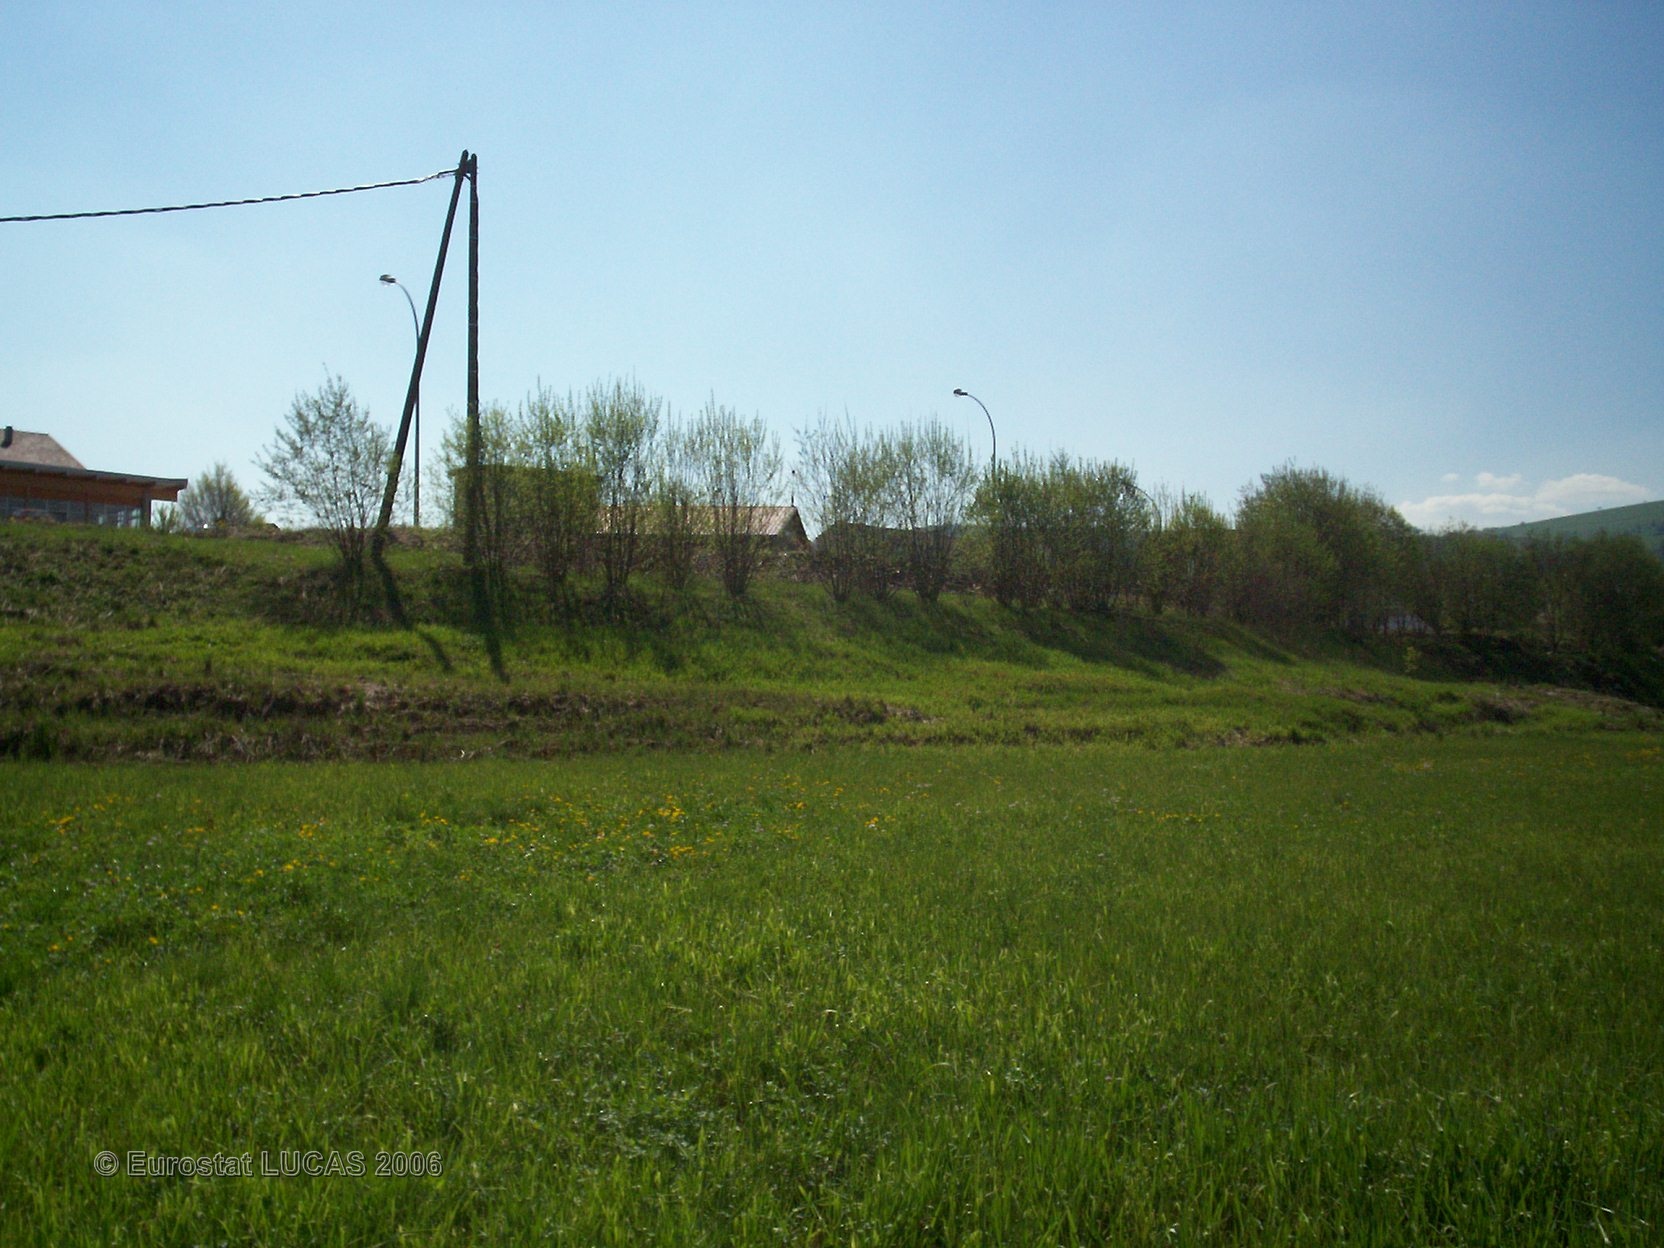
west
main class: Grassland
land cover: Grassland without tree/shrub cover
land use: Wetland
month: May
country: FR
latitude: 47.0548
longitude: 6.6189
